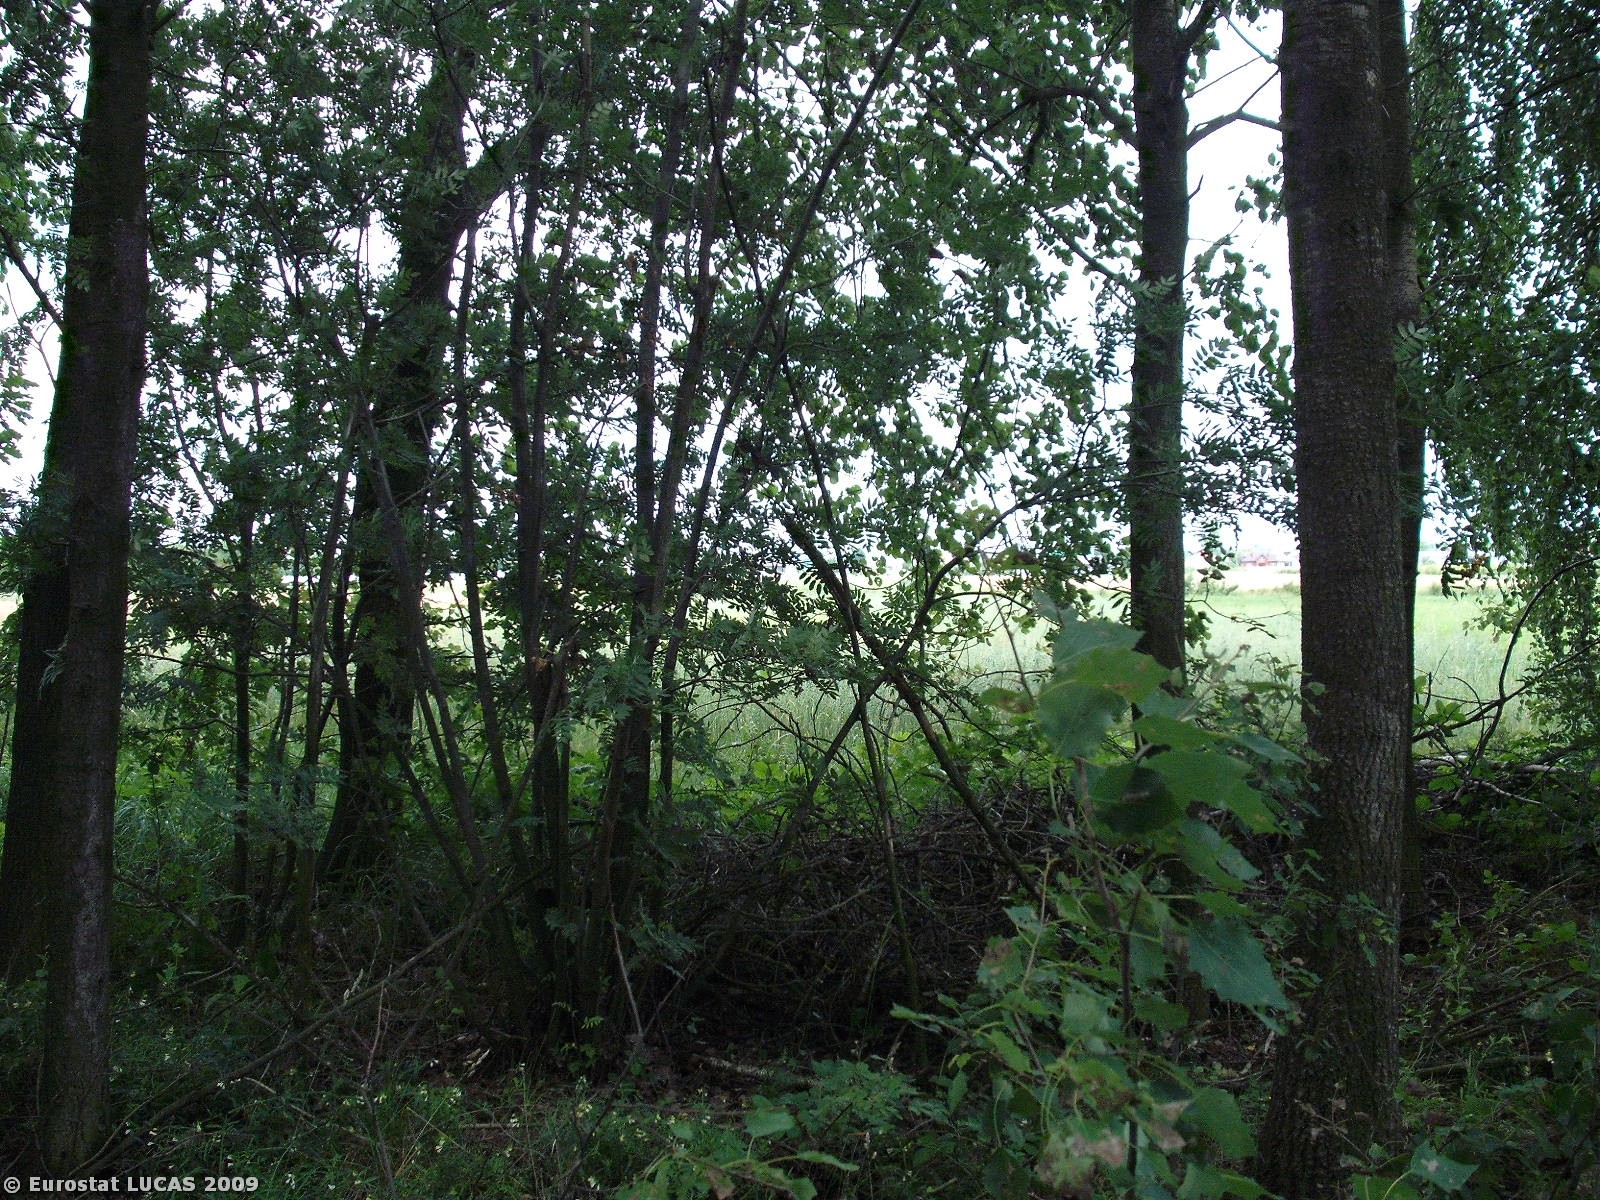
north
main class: Woodland
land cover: Broadleaved woodland
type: mesophytic deciduous forest
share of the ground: > 75 %
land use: Forestry
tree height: > 5 m
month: July
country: PL
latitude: 51.4973
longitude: 20.6564
